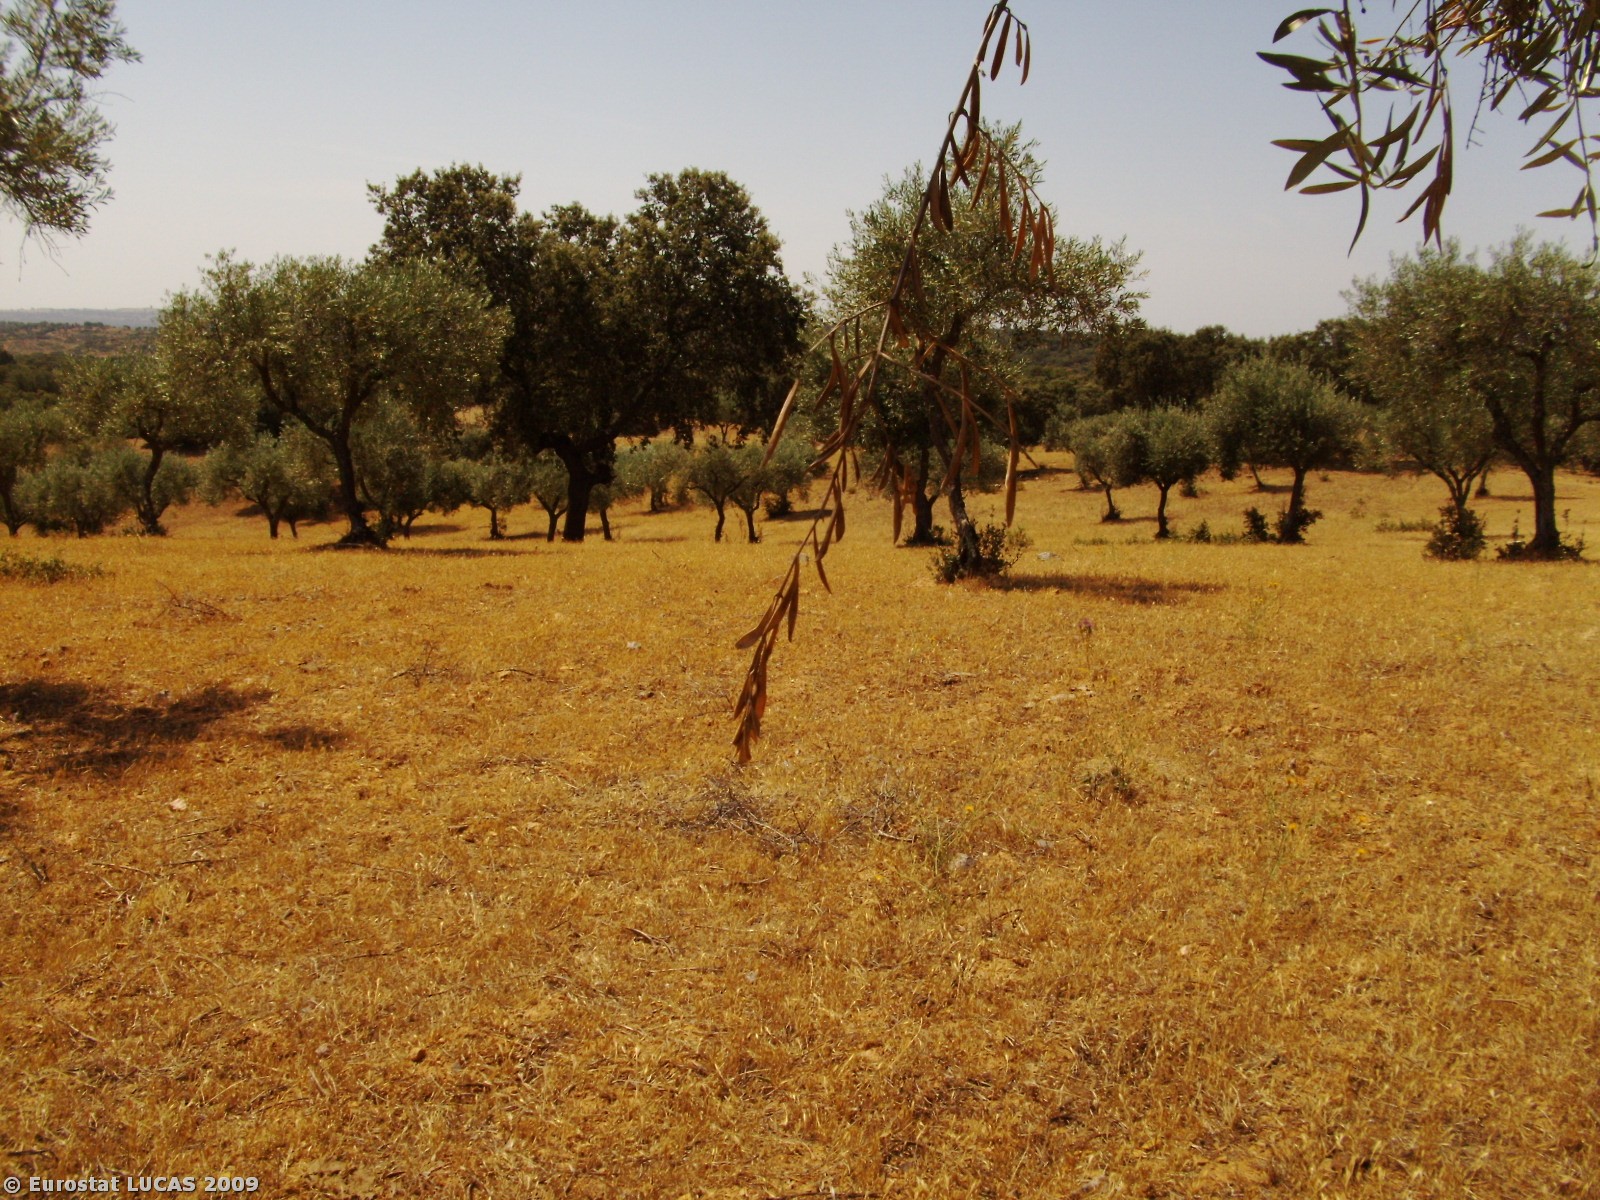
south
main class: Cropland
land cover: Olive groves
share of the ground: 50 - 75 %
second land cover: Spontaneously vegetated surfaces
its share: 10 - 25 %
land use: Agriculture (excluding fallow land and kitchen gardens)
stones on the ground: > 50 %
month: June
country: PT
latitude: 39.8252
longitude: -7.0890
